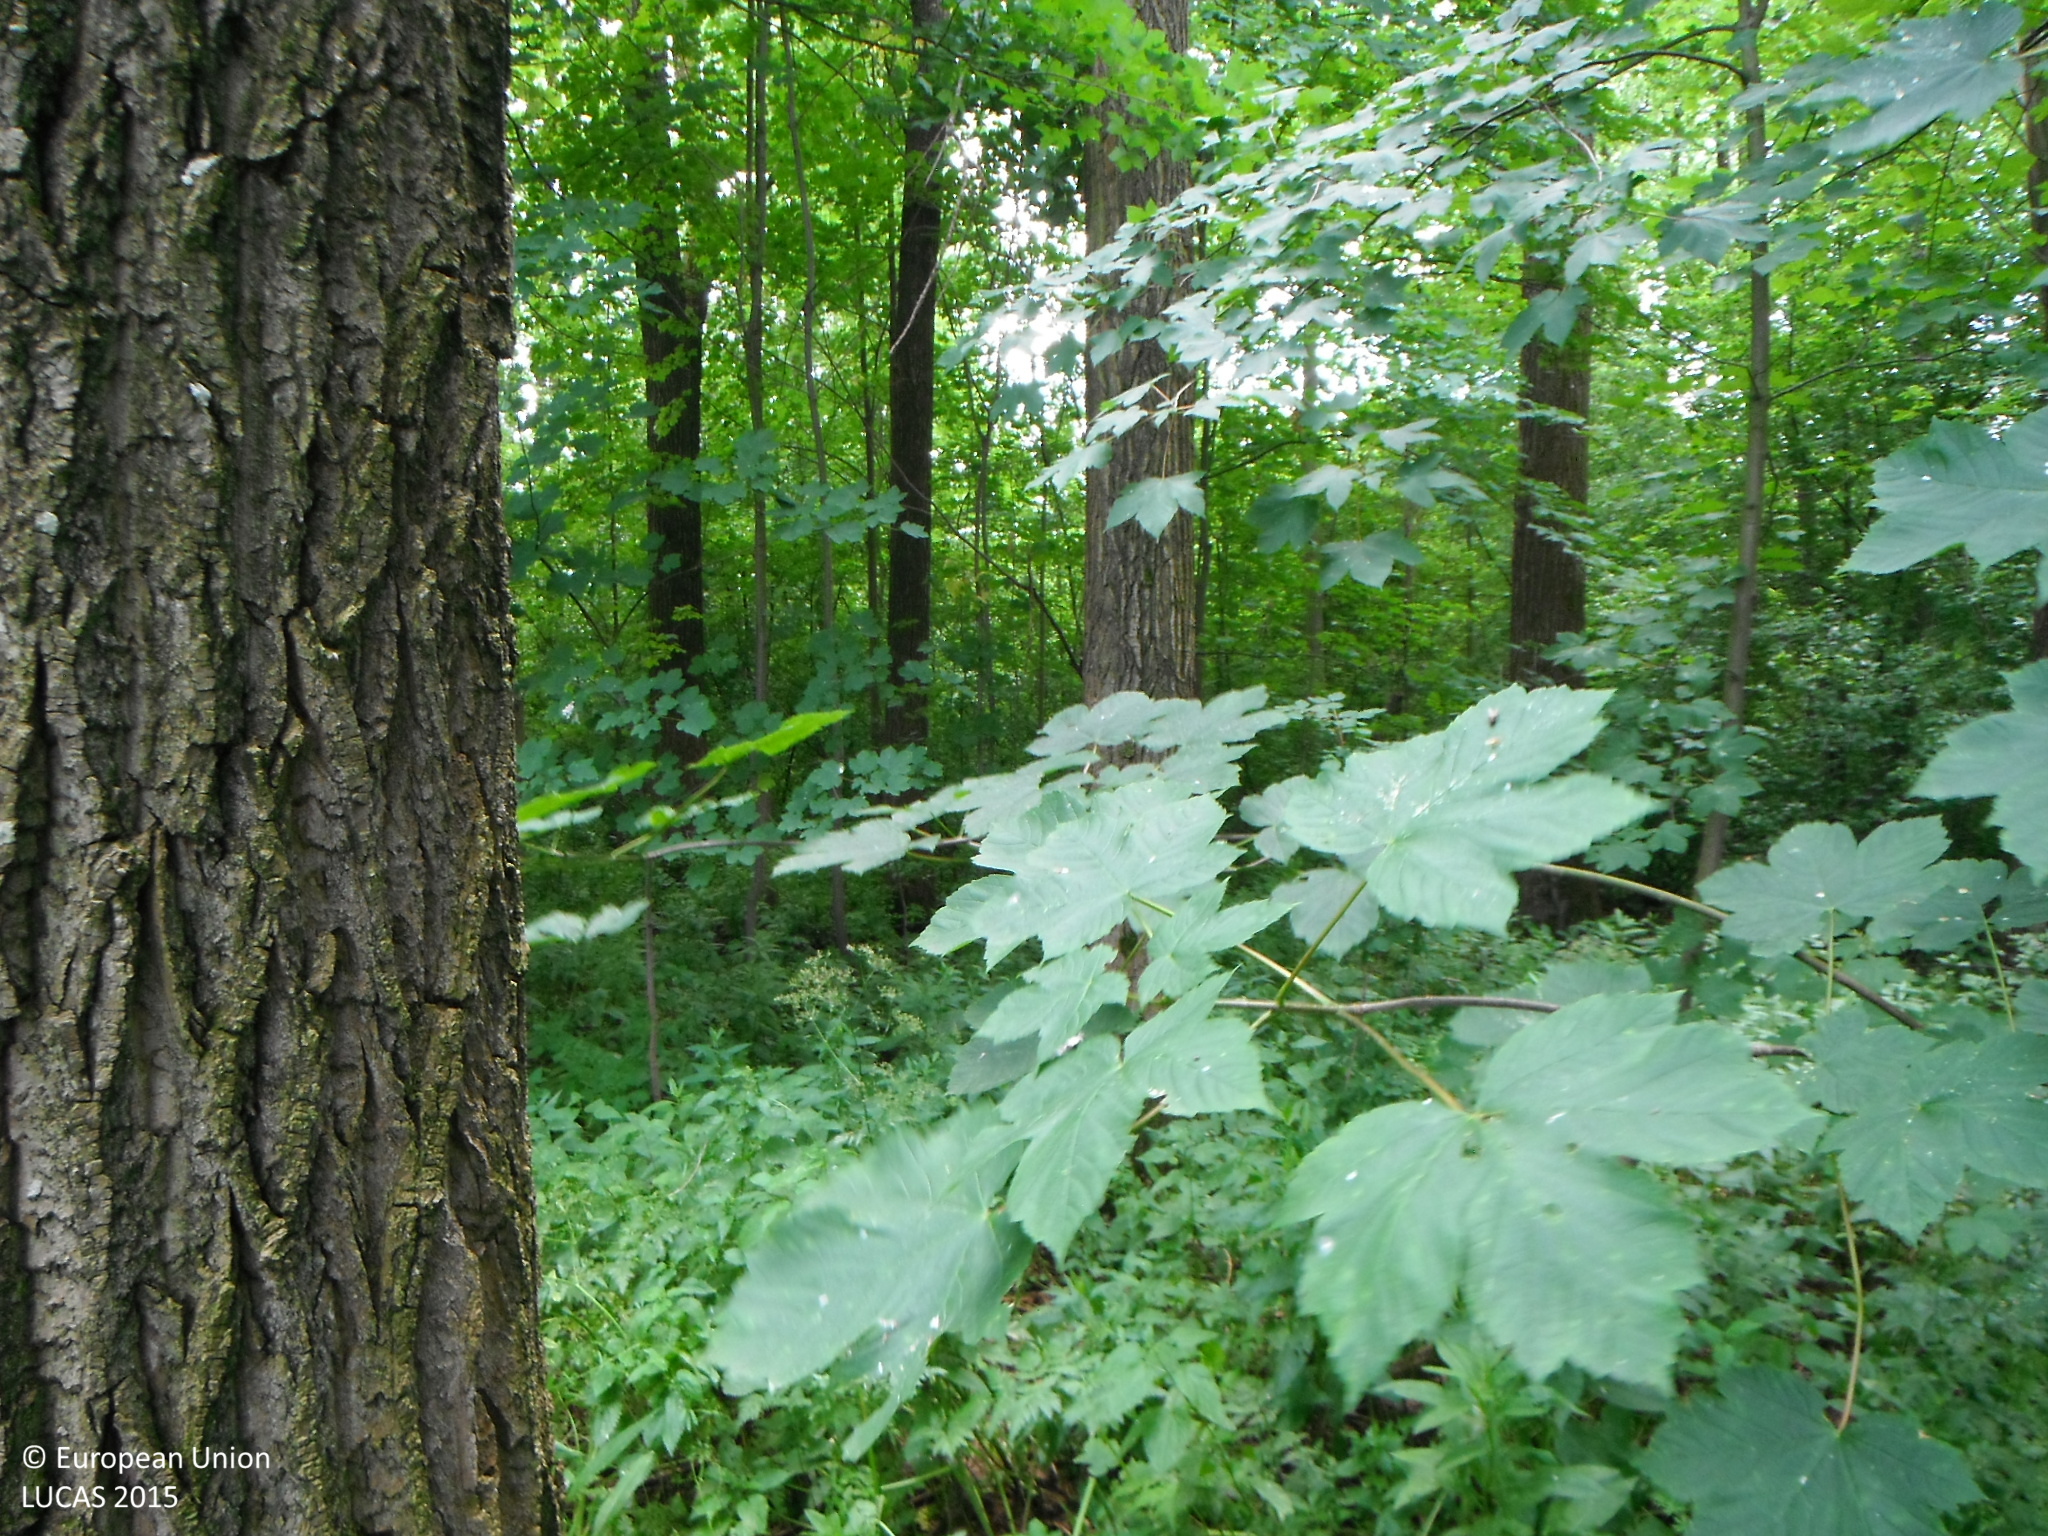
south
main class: Woodland
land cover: Broadleaved woodland
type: floodplain forest
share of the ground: > 75 %
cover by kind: broadleaved forest trees 75 %, herbaceous plants 25 %
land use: Forestry
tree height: > 5 m
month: July
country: SK
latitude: 49.4224
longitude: 19.5254
